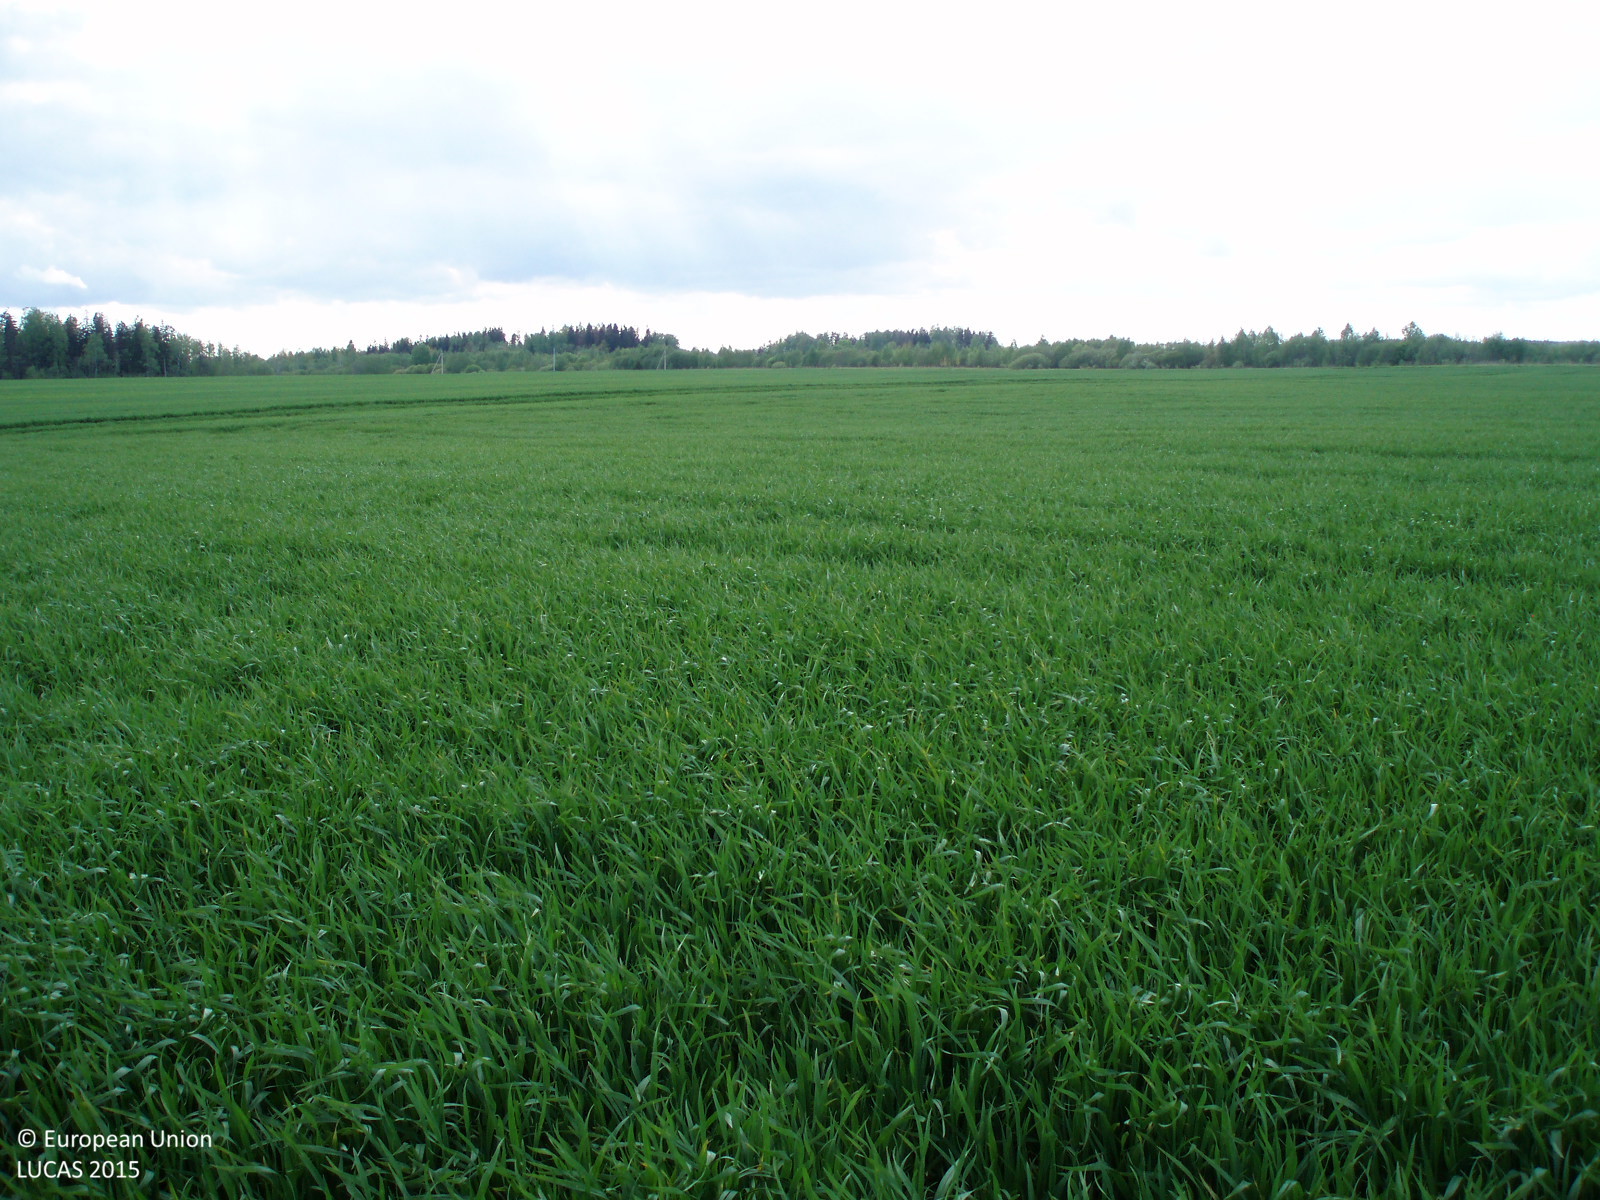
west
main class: Cropland
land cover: Common wheat
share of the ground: > 75 %
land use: Agriculture (excluding fallow land and kitchen gardens)
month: May
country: LT
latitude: 56.3421
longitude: 22.4659
